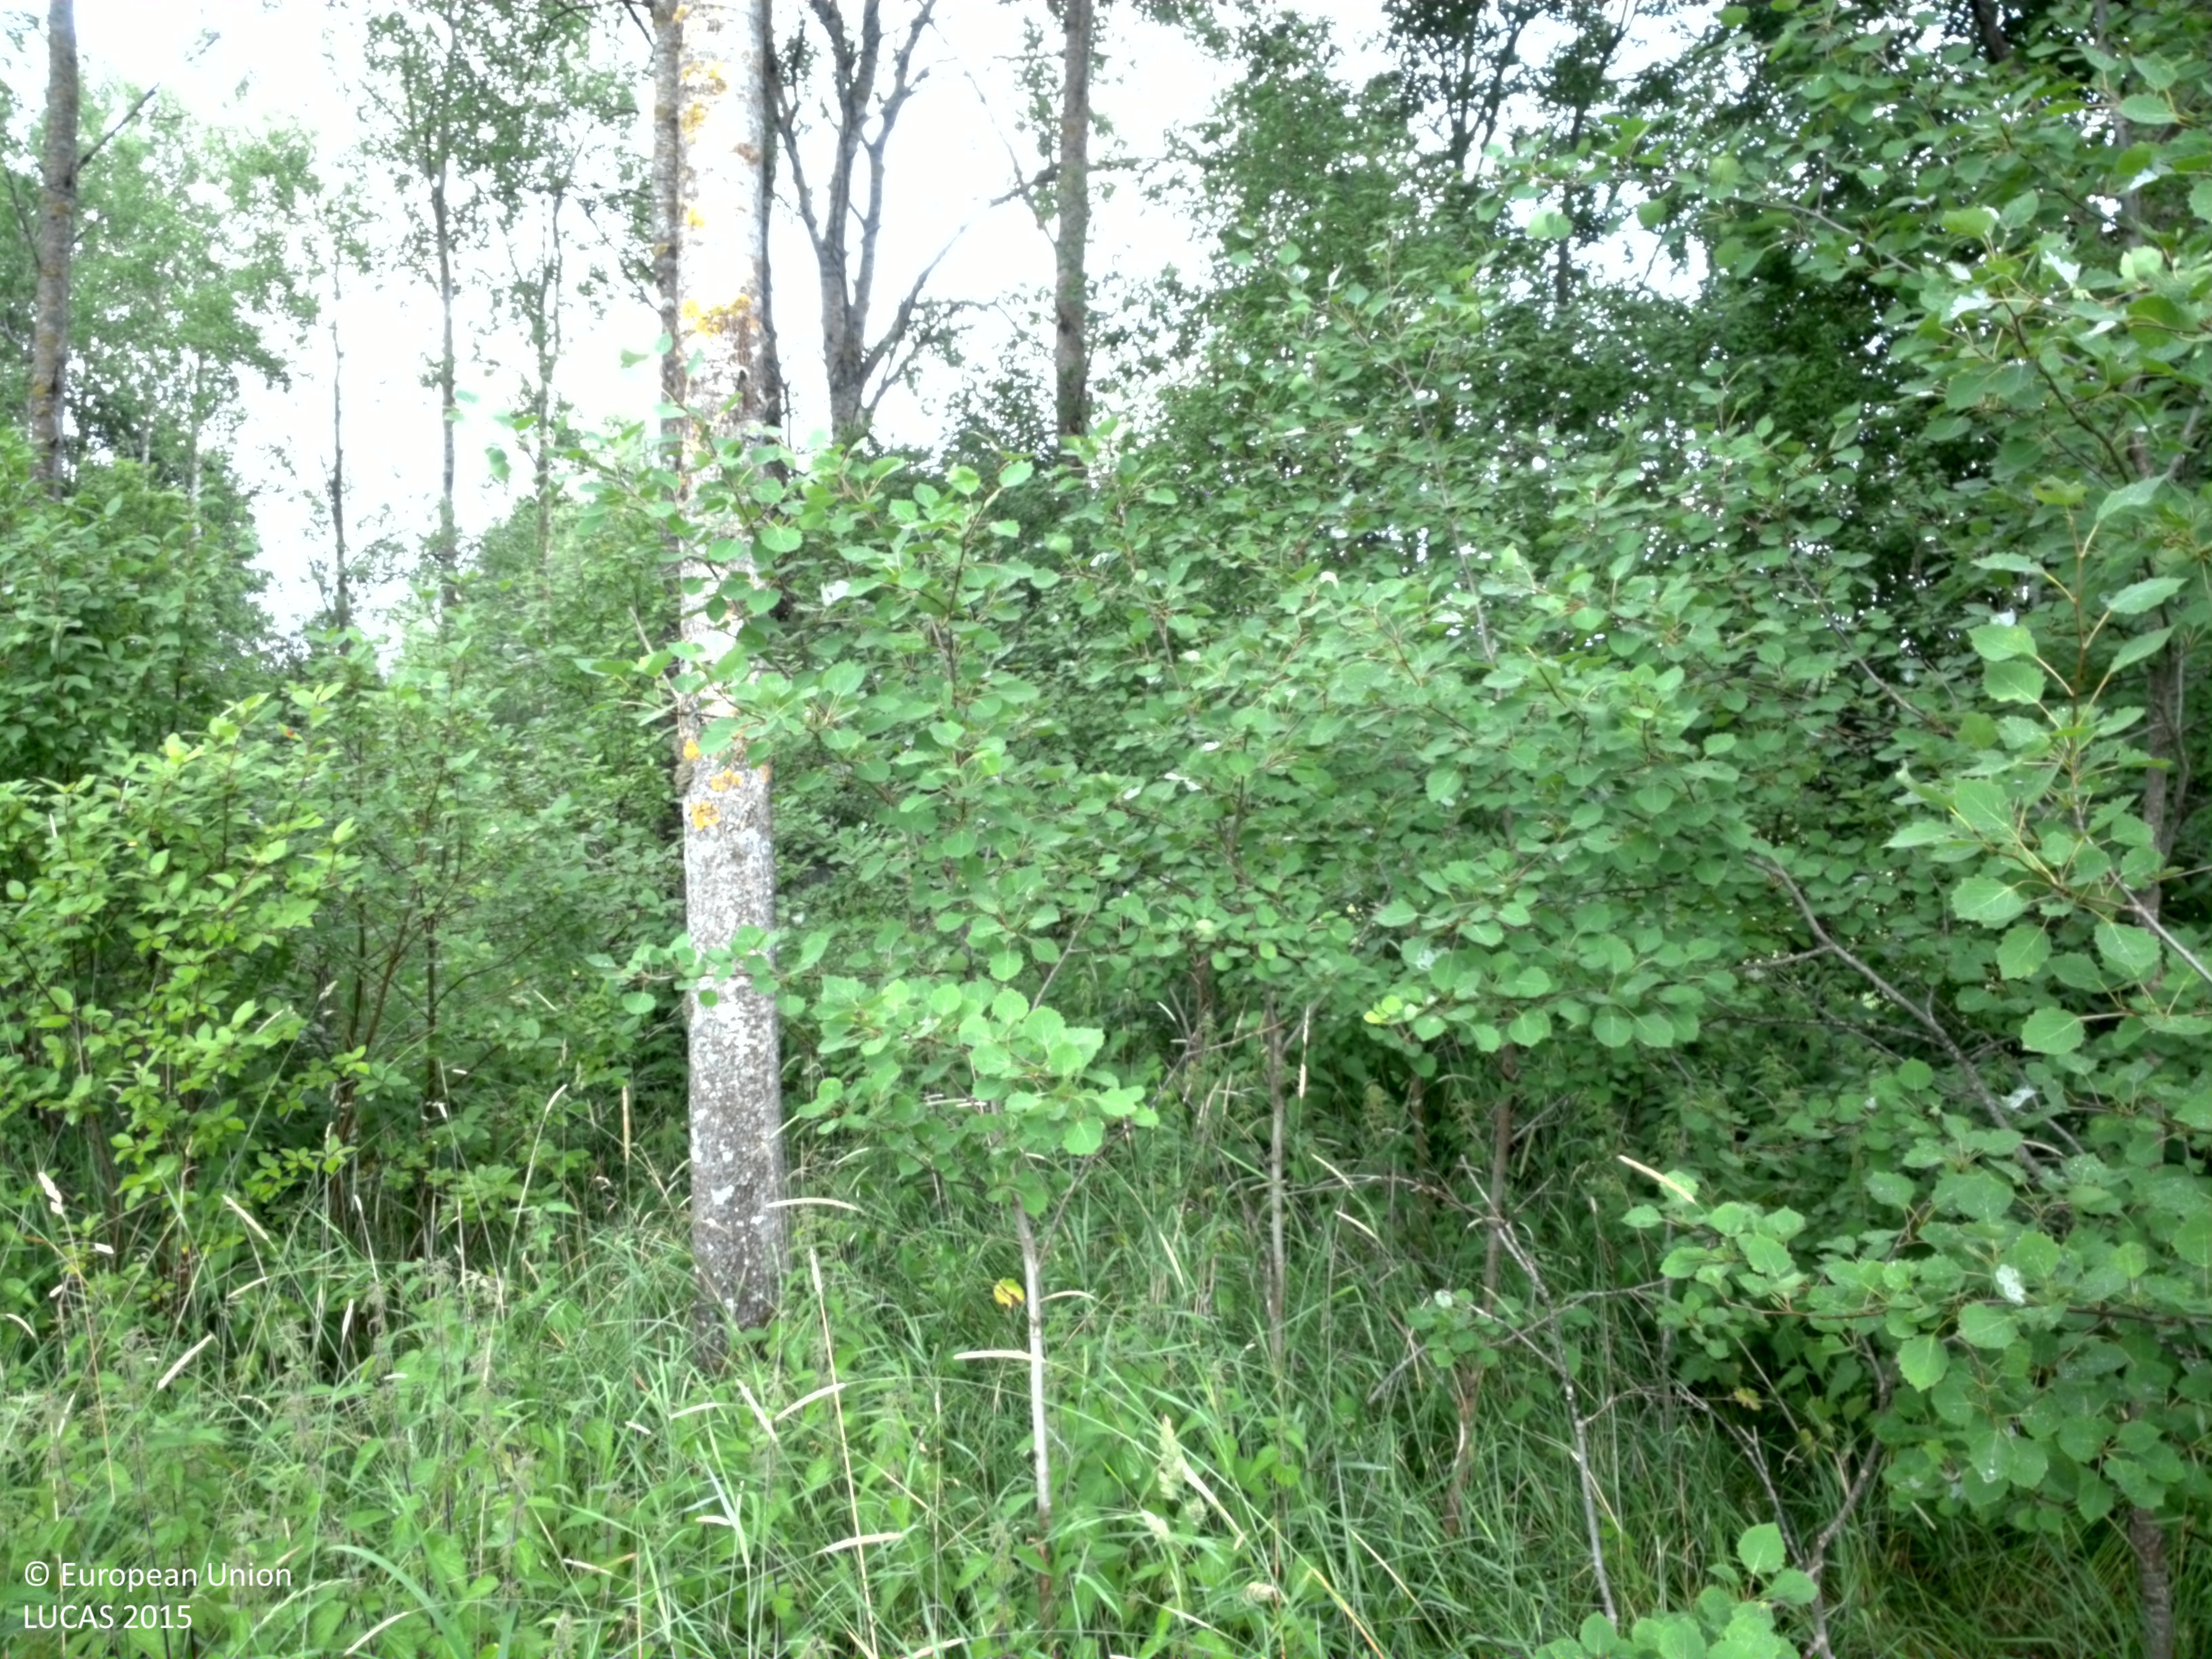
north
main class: Woodland
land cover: Broadleaved woodland
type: hemiboreal forest and nemoral coniferous forest and mixed broadleaved-coniferous forest
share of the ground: 25 - 50 %
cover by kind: broadleaved forest trees 50 %, herbaceous plants 50 %
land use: Semi-natural and natural areas not in use
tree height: > 5 m
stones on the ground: < 10 %
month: July
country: SE
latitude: 59.9734
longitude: 18.5799
